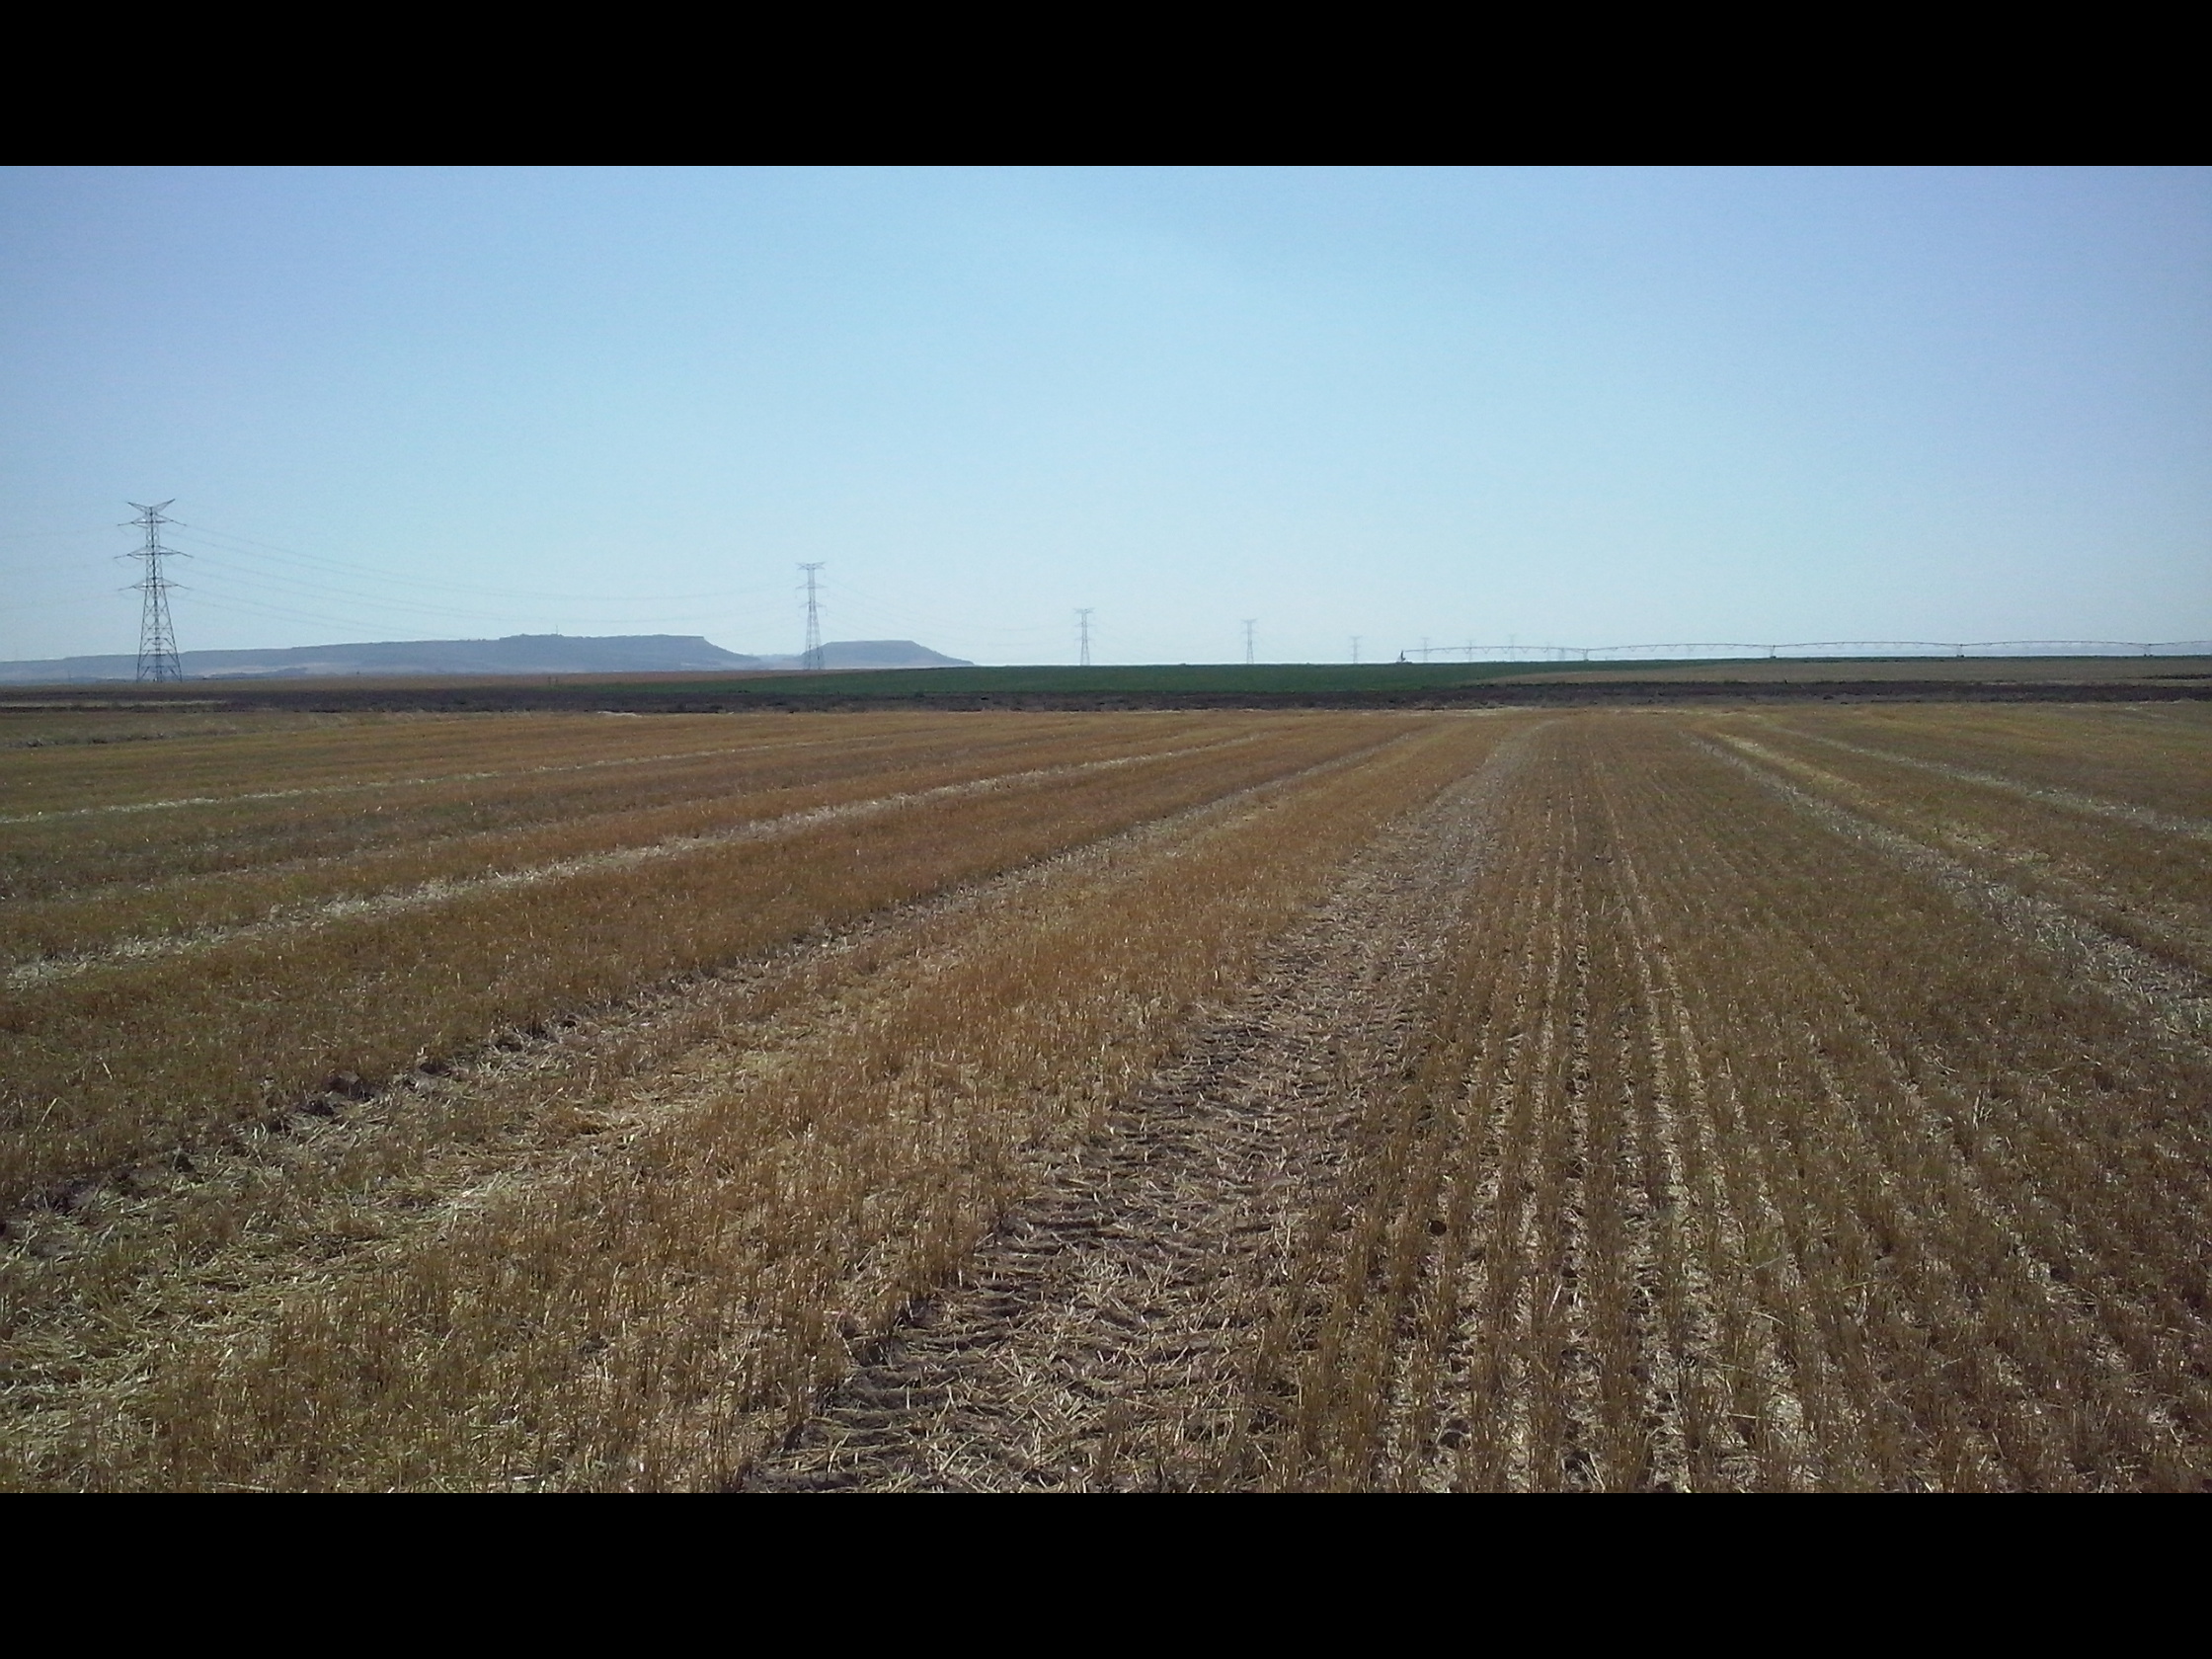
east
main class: Cropland
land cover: Barley
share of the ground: < 10 %
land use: Agriculture (excluding fallow land and kitchen gardens)
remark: Harvested field
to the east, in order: Barley; Grass margins; Other bare soil
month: July
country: ES
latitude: 41.5304
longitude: -5.1158
